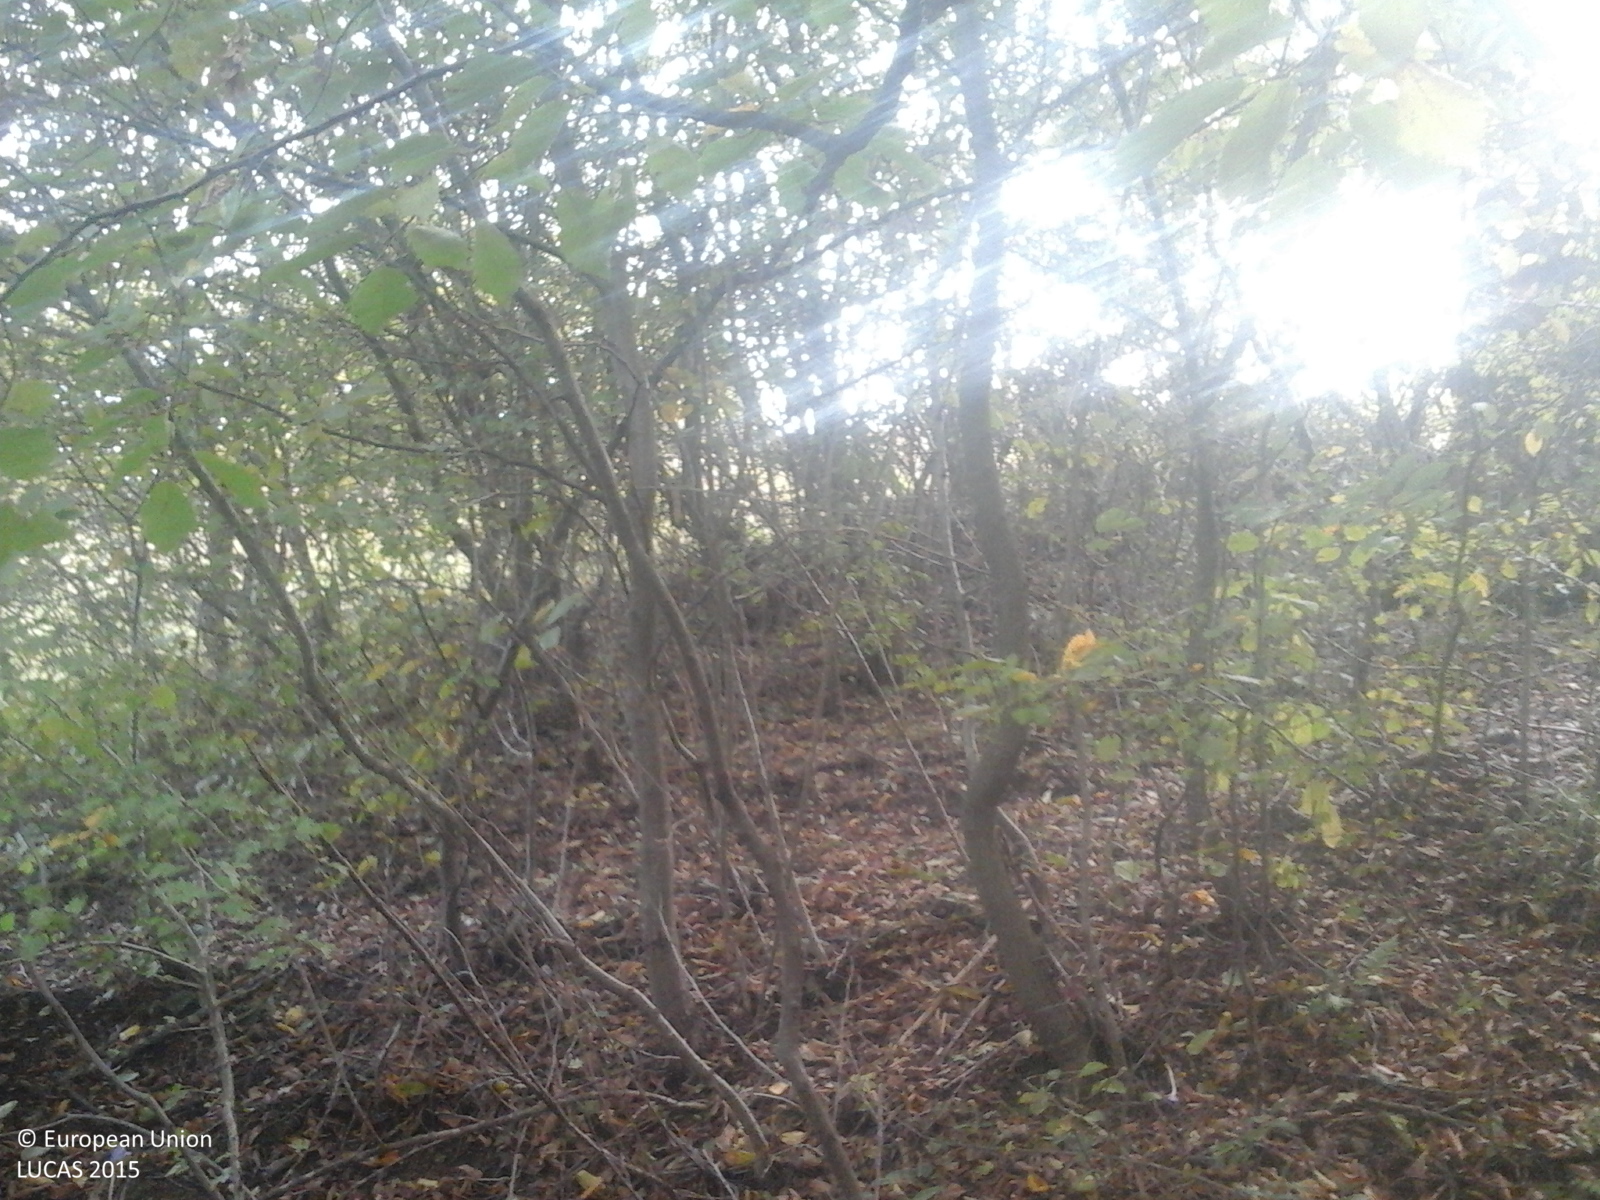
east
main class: Woodland
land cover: Broadleaved woodland
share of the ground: > 75 %
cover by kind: broadleaved forest trees 100 %
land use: Forestry
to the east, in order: Broadleaved woodland; Grassland with sparse tree/shrub cover; Broadleaved woodland; Grassland with sparse tree/shrub cover; Grassland without tree/shrub cover; Grassland with sparse tree/shrub cover
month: October
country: RO
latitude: 46.1234
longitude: 25.4134
